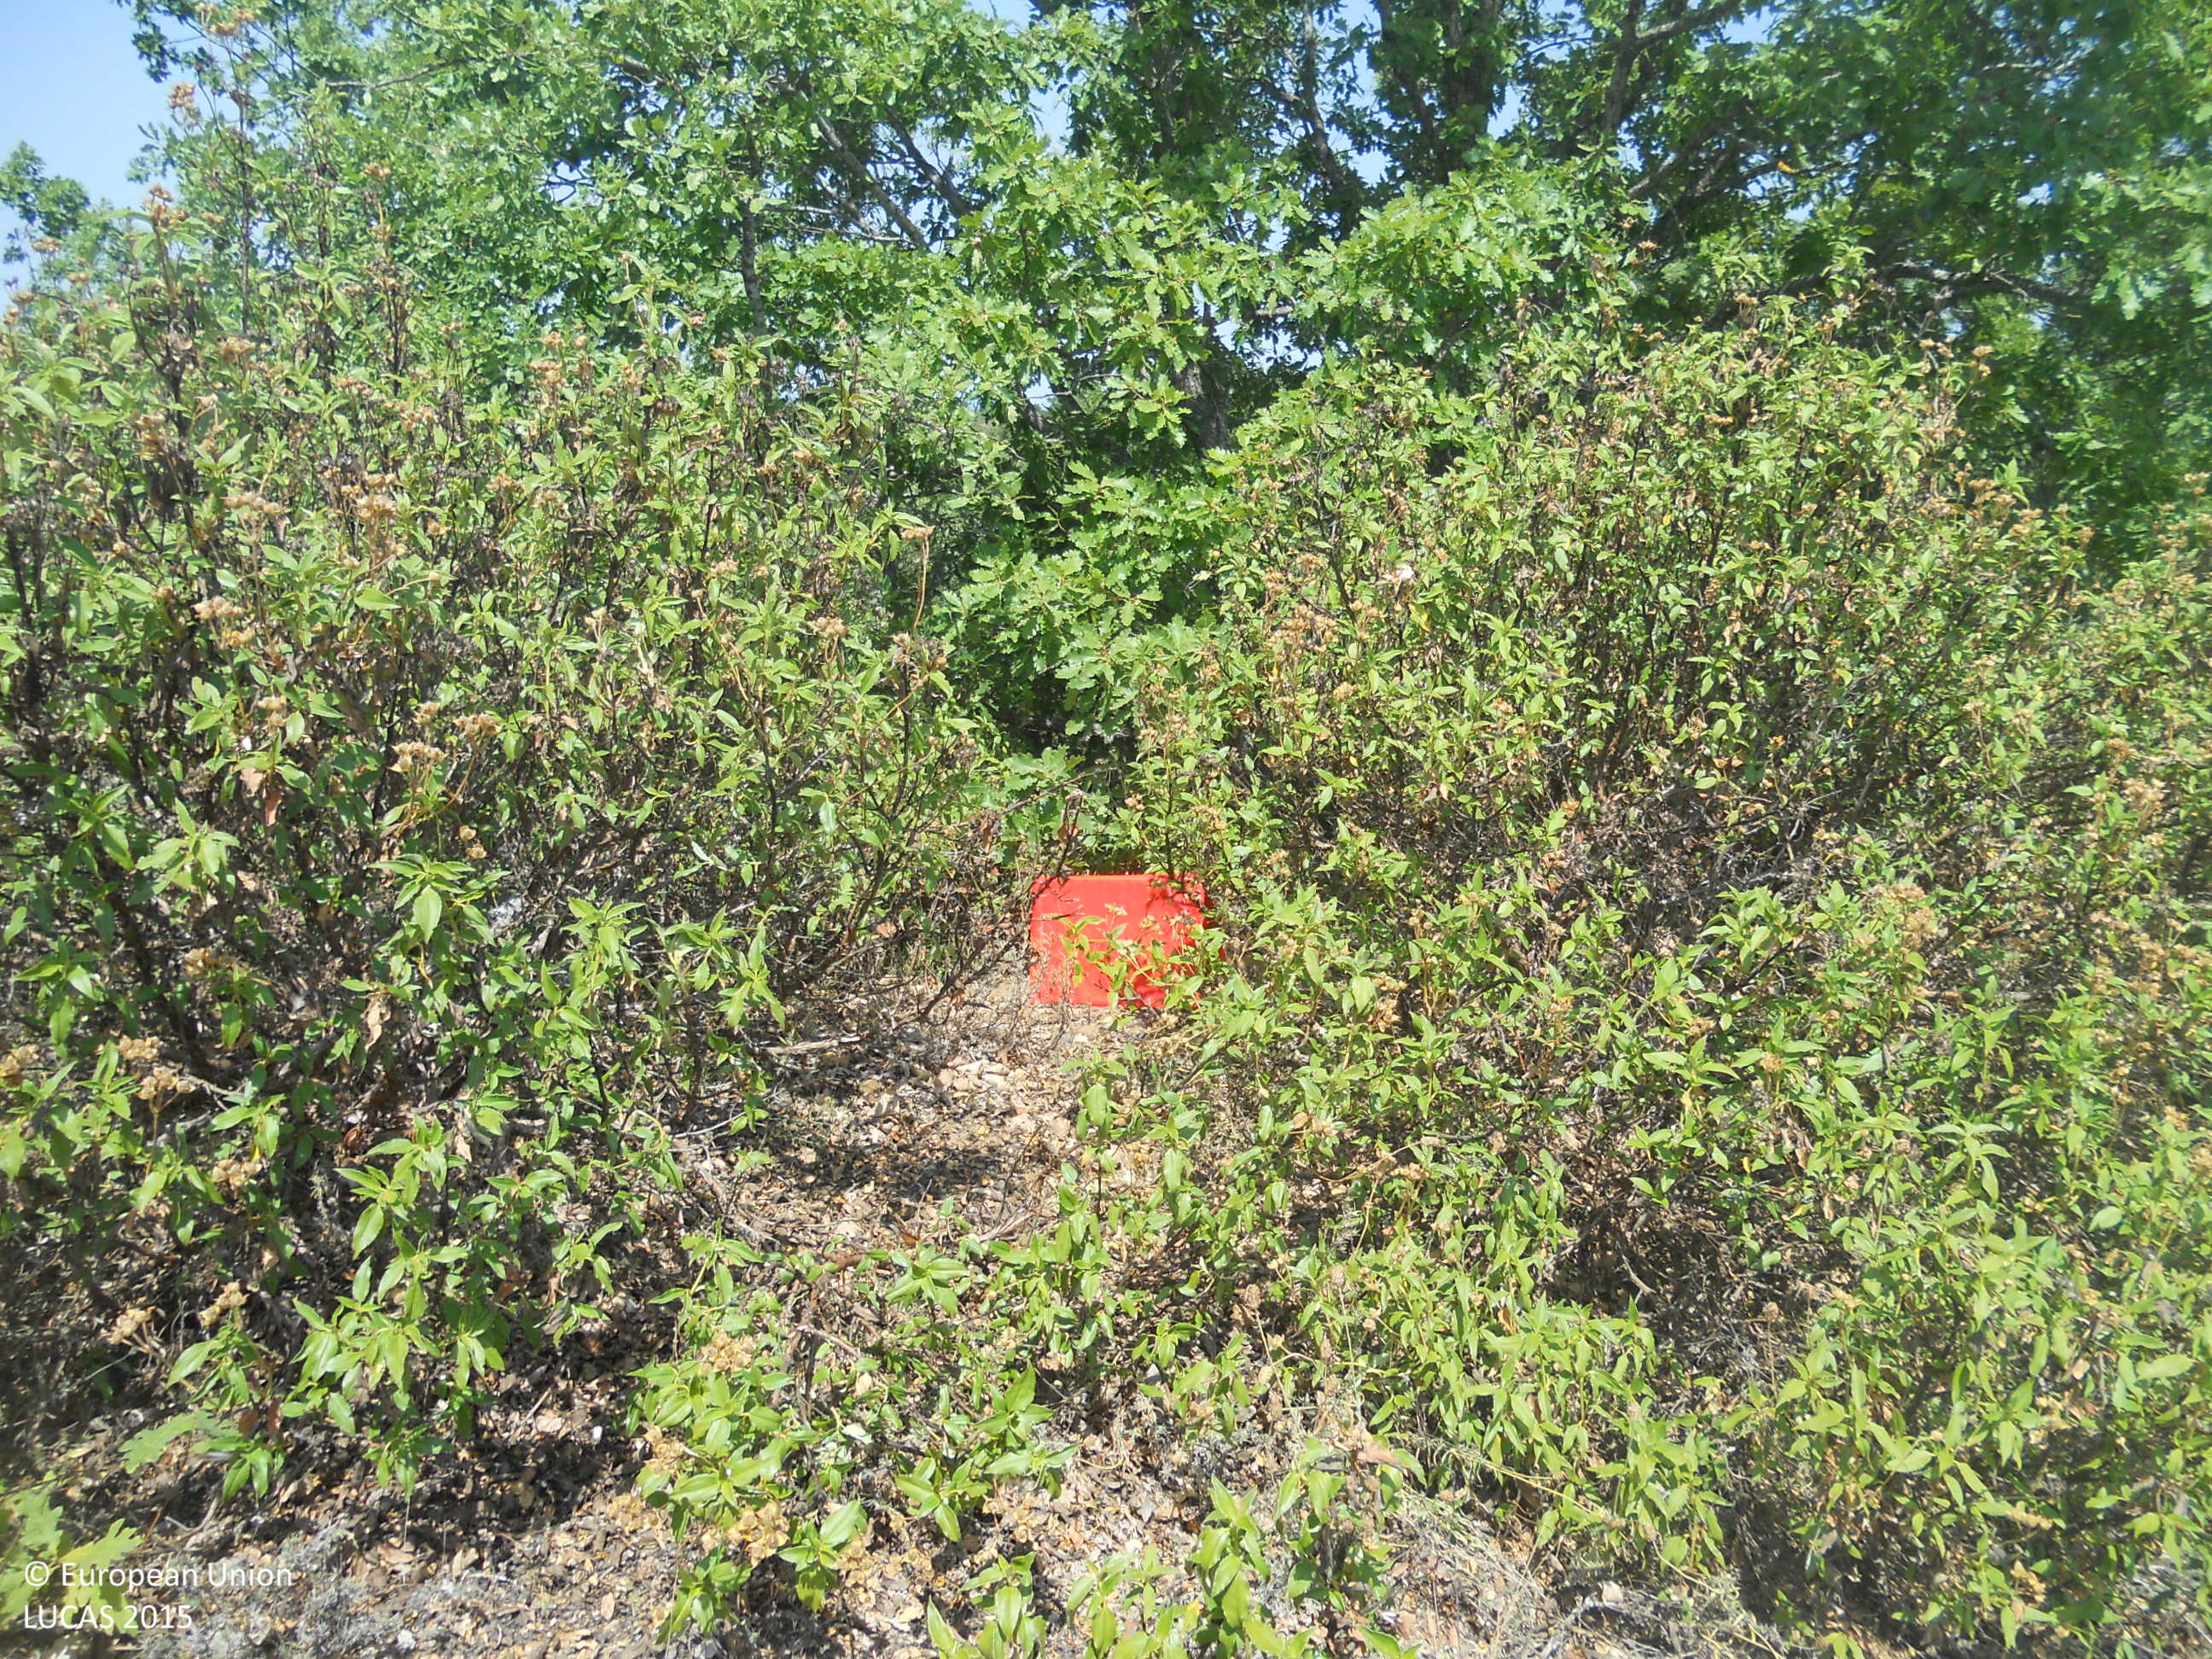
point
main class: Woodland
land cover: Broadleaved woodland
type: thermophilous deciduous forest
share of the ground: 25 - 50 %
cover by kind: broadleaved forest trees 40 %, shrubs 30 %, unconsolidated bare surface 20 %, herbaceous plants 10 %
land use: Semi-natural and natural areas not in use
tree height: < 5 m
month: July
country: ES
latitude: 42.6145
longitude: -5.3433
